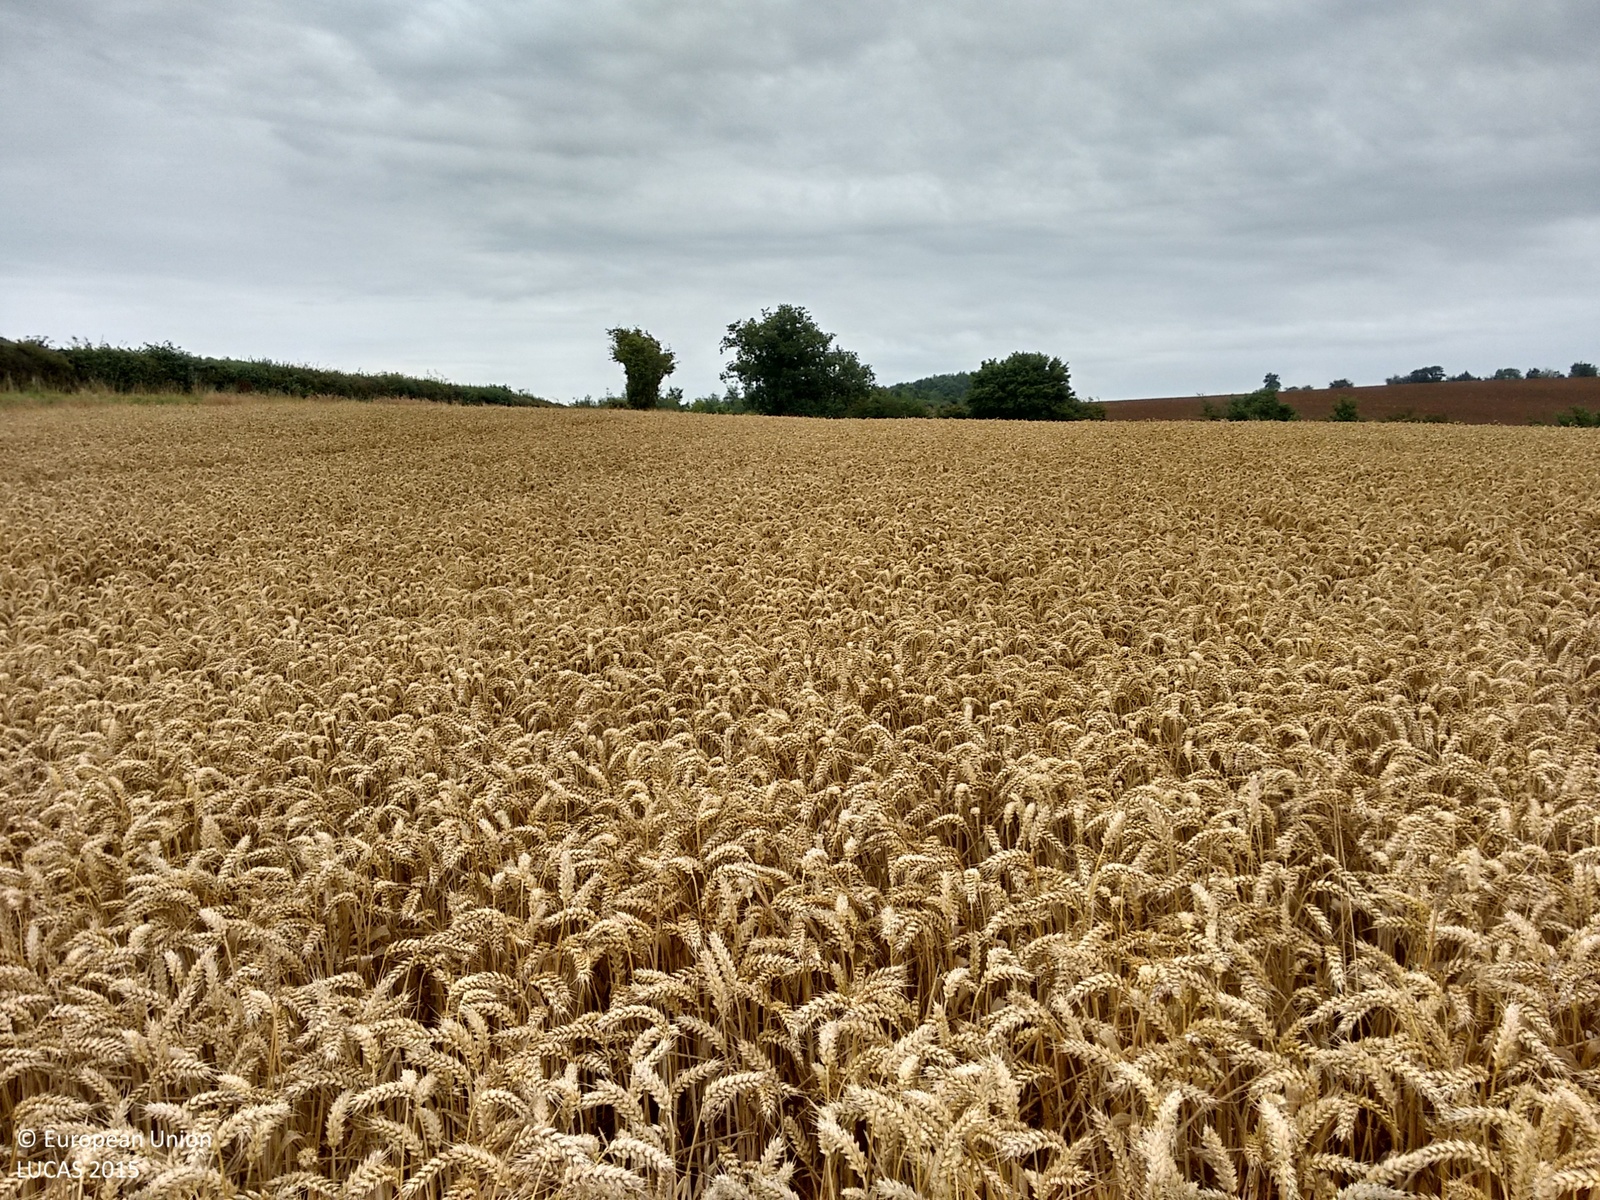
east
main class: Cropland
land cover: Common wheat
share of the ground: > 75 %
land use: Agriculture (excluding fallow land and kitchen gardens)
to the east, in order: Common wheat; Fences; Managed hedges; Grass margins; Other bare soil; Fences; Managed hedges
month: August
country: GB
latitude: 52.1488
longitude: -1.2570
